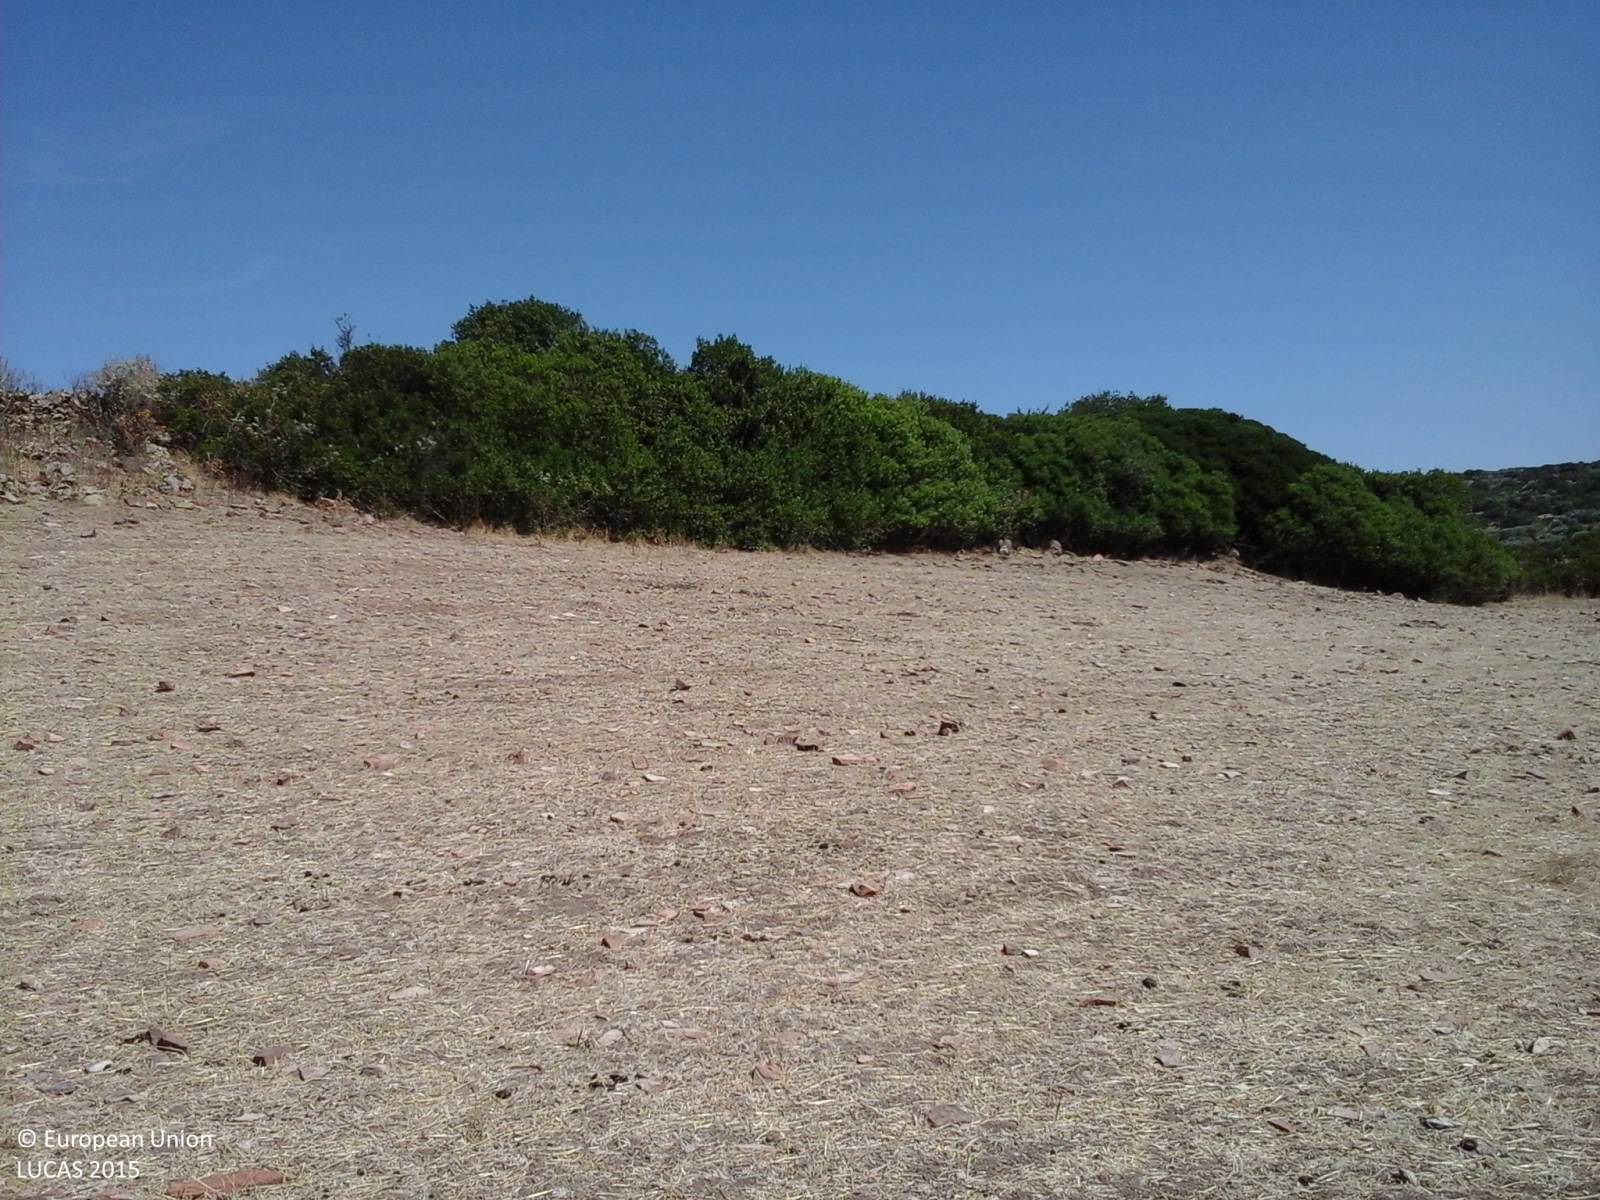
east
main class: Woodland
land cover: Broadleaved woodland
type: broadleaved evergreen forest
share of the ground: > 75 %
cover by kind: broadleaved forest trees 100 %
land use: Forestry
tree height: < 5 m
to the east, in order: Broadleaved woodland; Abandoned hedges; Grassland without tree/shrub cover; Abandoned hedges; Dry stone walls; Grassland without tree/shrub cover; Abandoned hedges; Grassland without tree/shrub cover; Dry stone walls; Tracks; Abandoned hedges; Grassland without tree/shrub cover
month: August
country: IT
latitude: 40.0800
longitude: 8.8919
